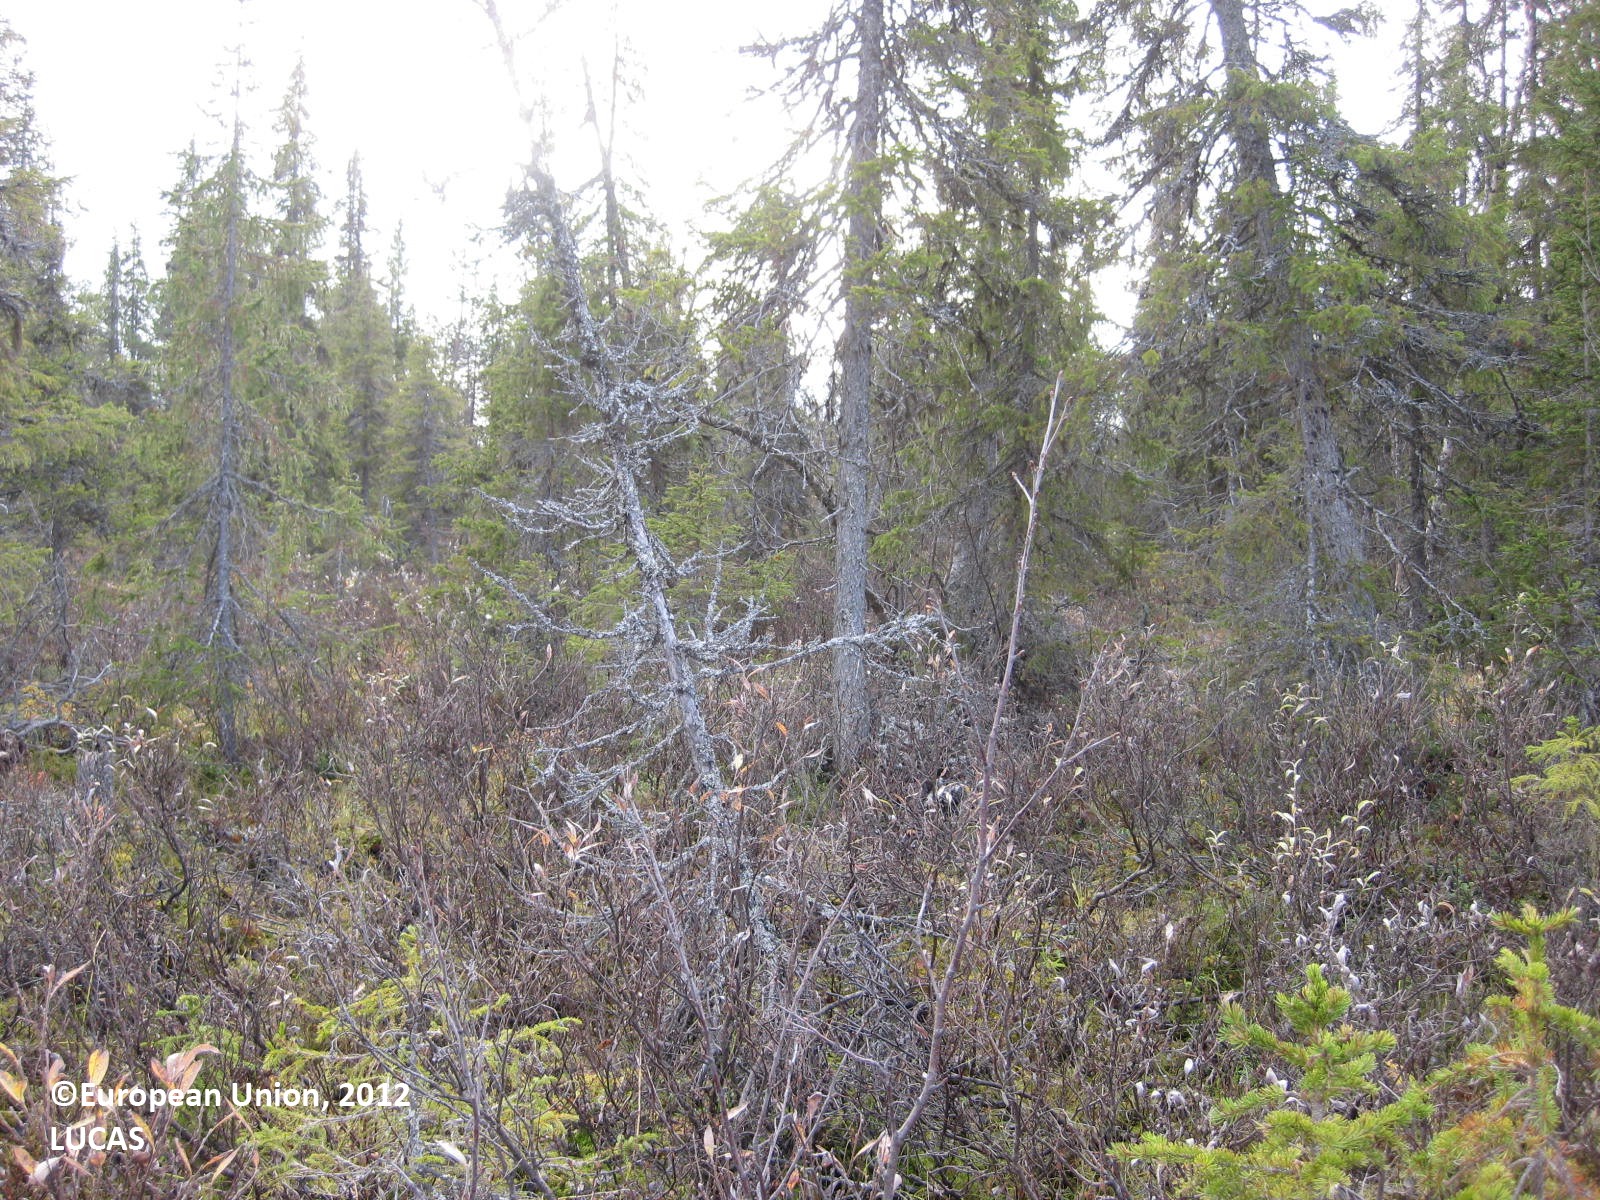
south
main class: Woodland
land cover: Pine dominated mixed woodland
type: boreal forest
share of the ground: 25 - 50 %
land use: Semi-natural and natural areas not in use
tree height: > 5 m
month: September
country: FI
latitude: 67.9908
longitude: 23.6163
